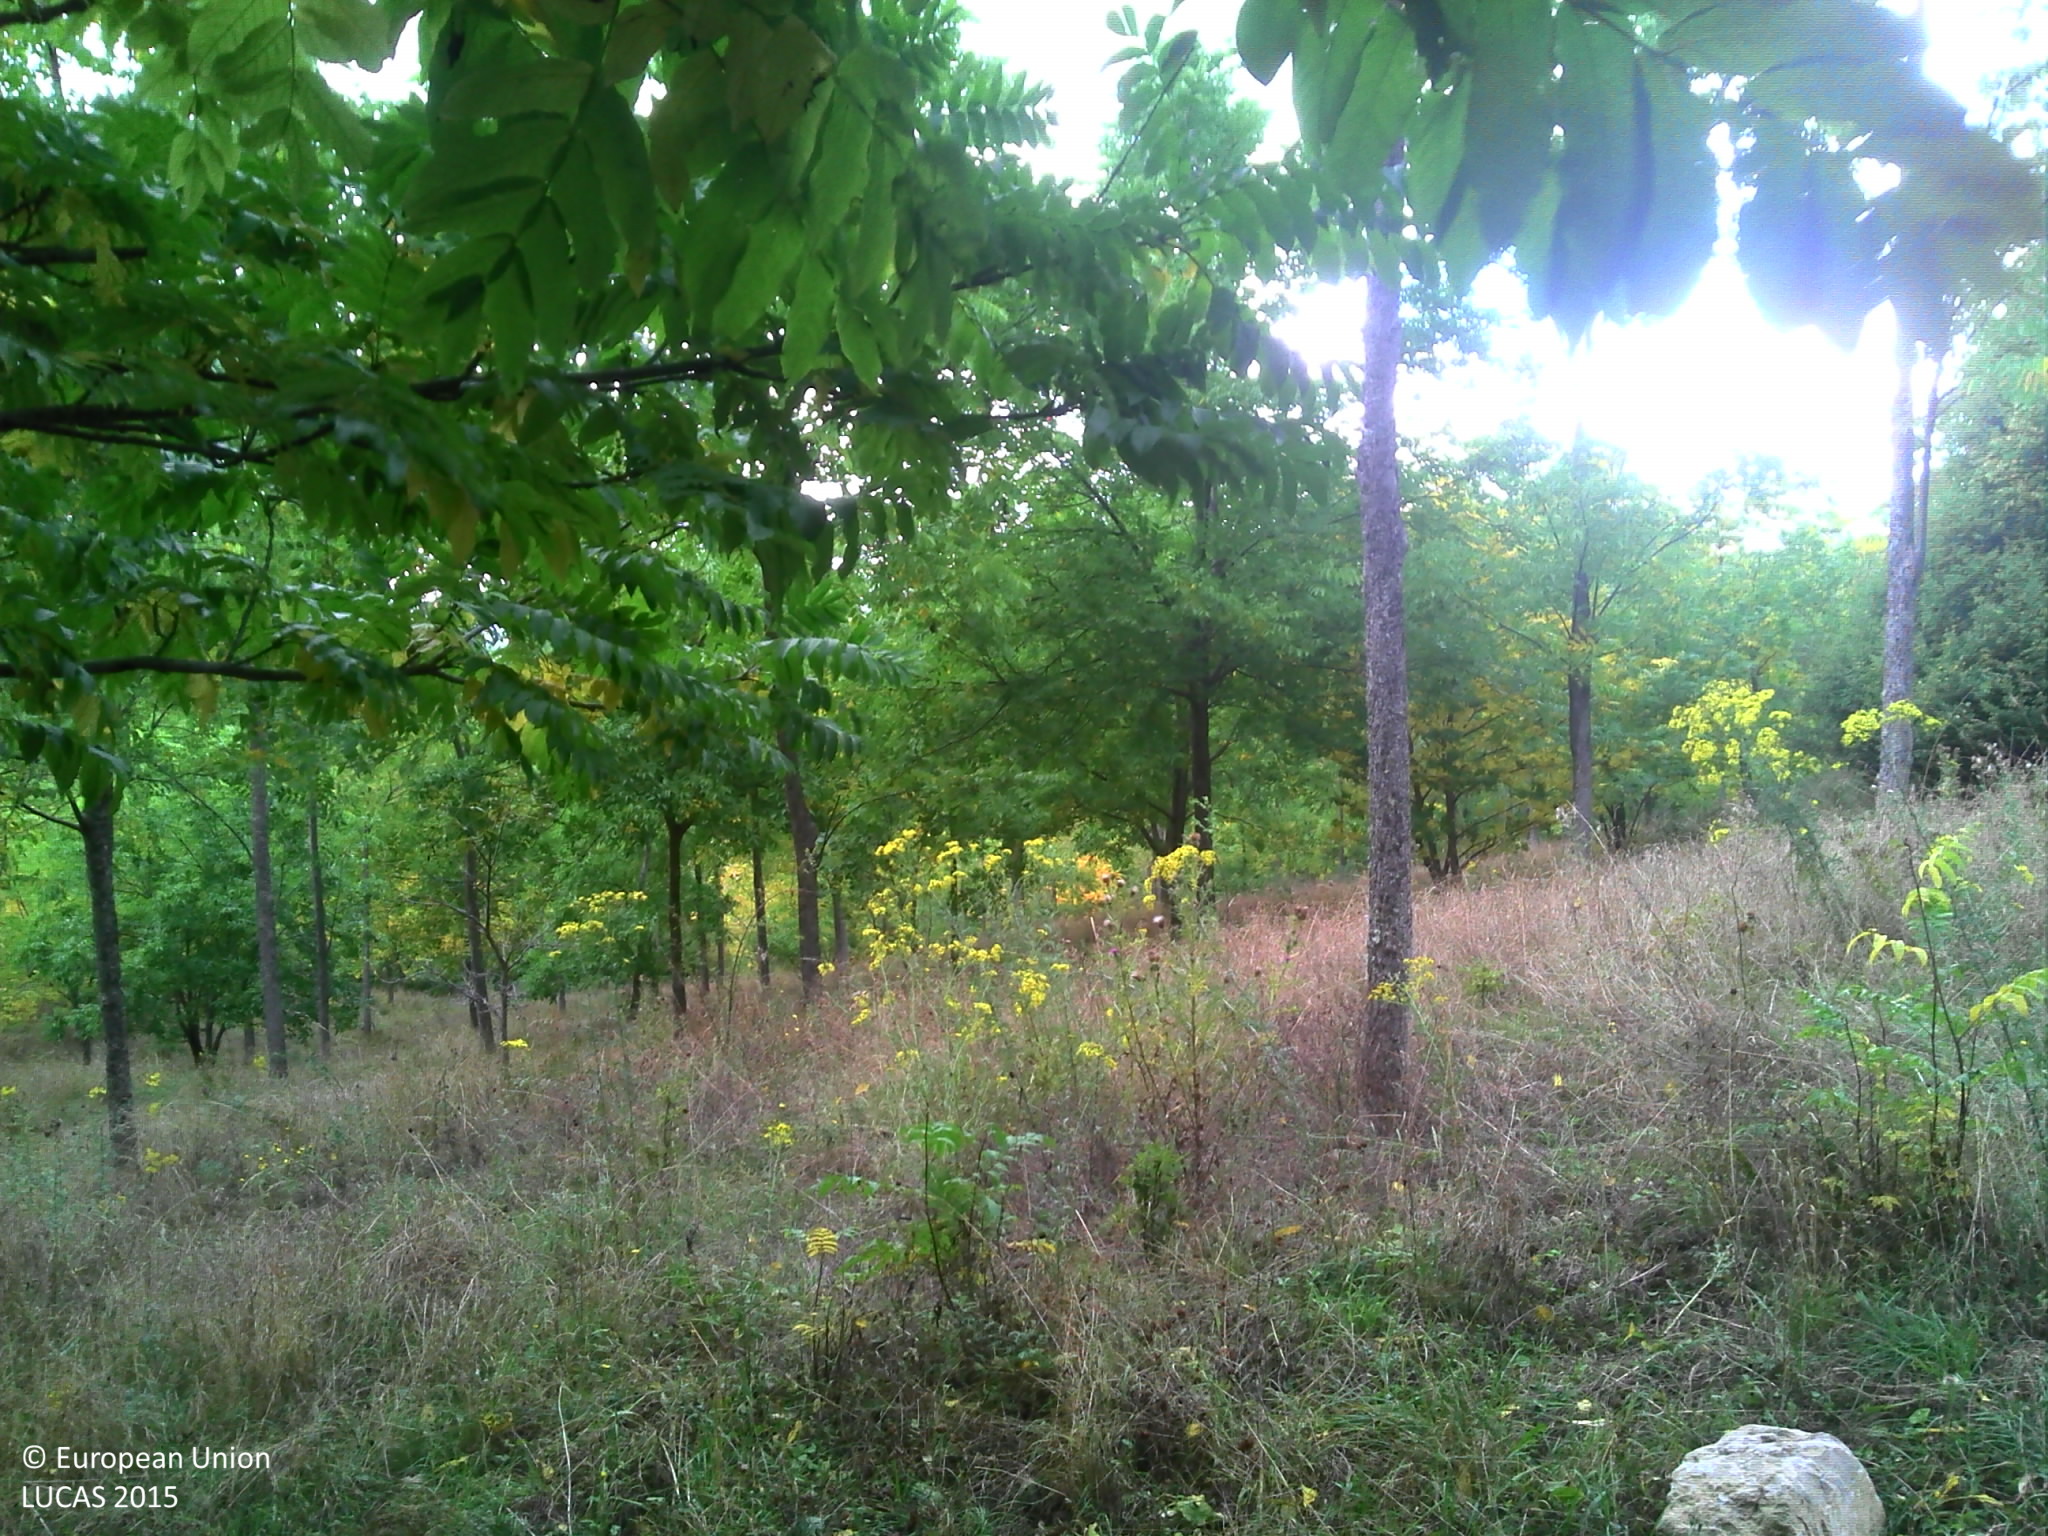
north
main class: Cropland
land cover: Nuts trees
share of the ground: 50 - 75 %
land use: Agriculture (excluding fallow land and kitchen gardens)
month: September
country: FR
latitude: 44.4346
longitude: 5.5222
